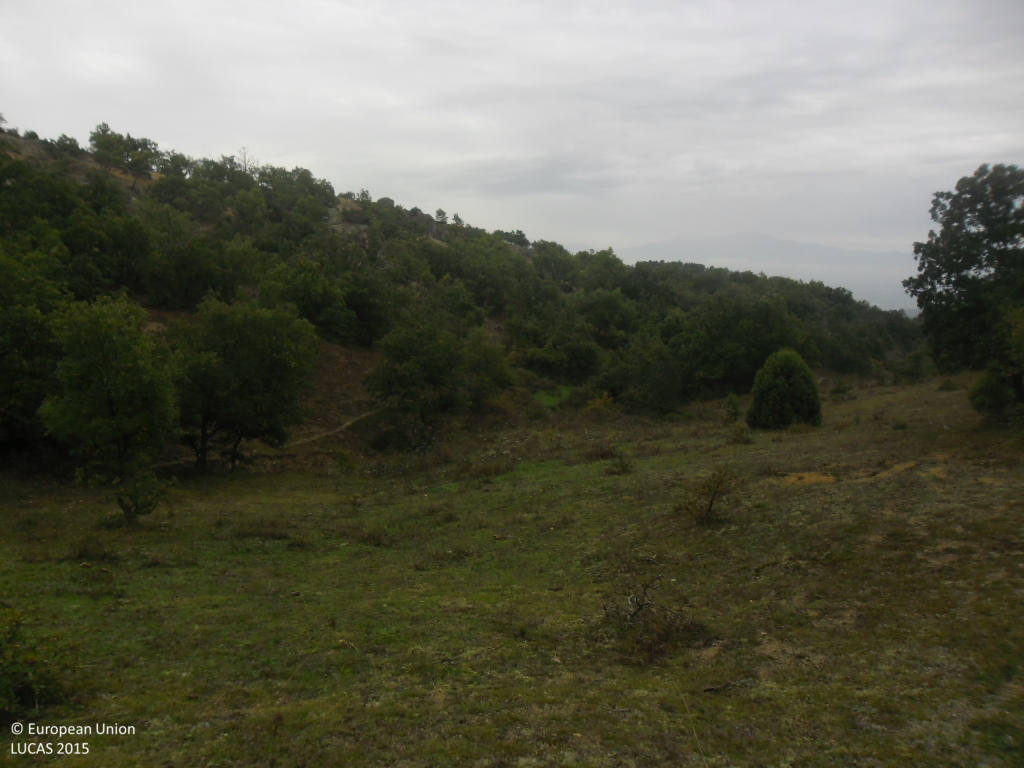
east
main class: Grassland
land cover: Grassland without tree/shrub cover
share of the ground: > 75 %
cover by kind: herbaceous plants 100 %
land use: Agriculture (excluding fallow land and kitchen gardens)
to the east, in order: Grassland without tree/shrub cover; Grassland with sparse tree/shrub cover; Rivers and streams; Tracks; Grassland with sparse tree/shrub cover; Rocks and stones; Grassland with sparse tree/shrub cover; Grassland without tree/shrub cover; Rocks and stones; Broadleaved woodland
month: October
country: BG
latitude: 41.5520
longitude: 23.1723
